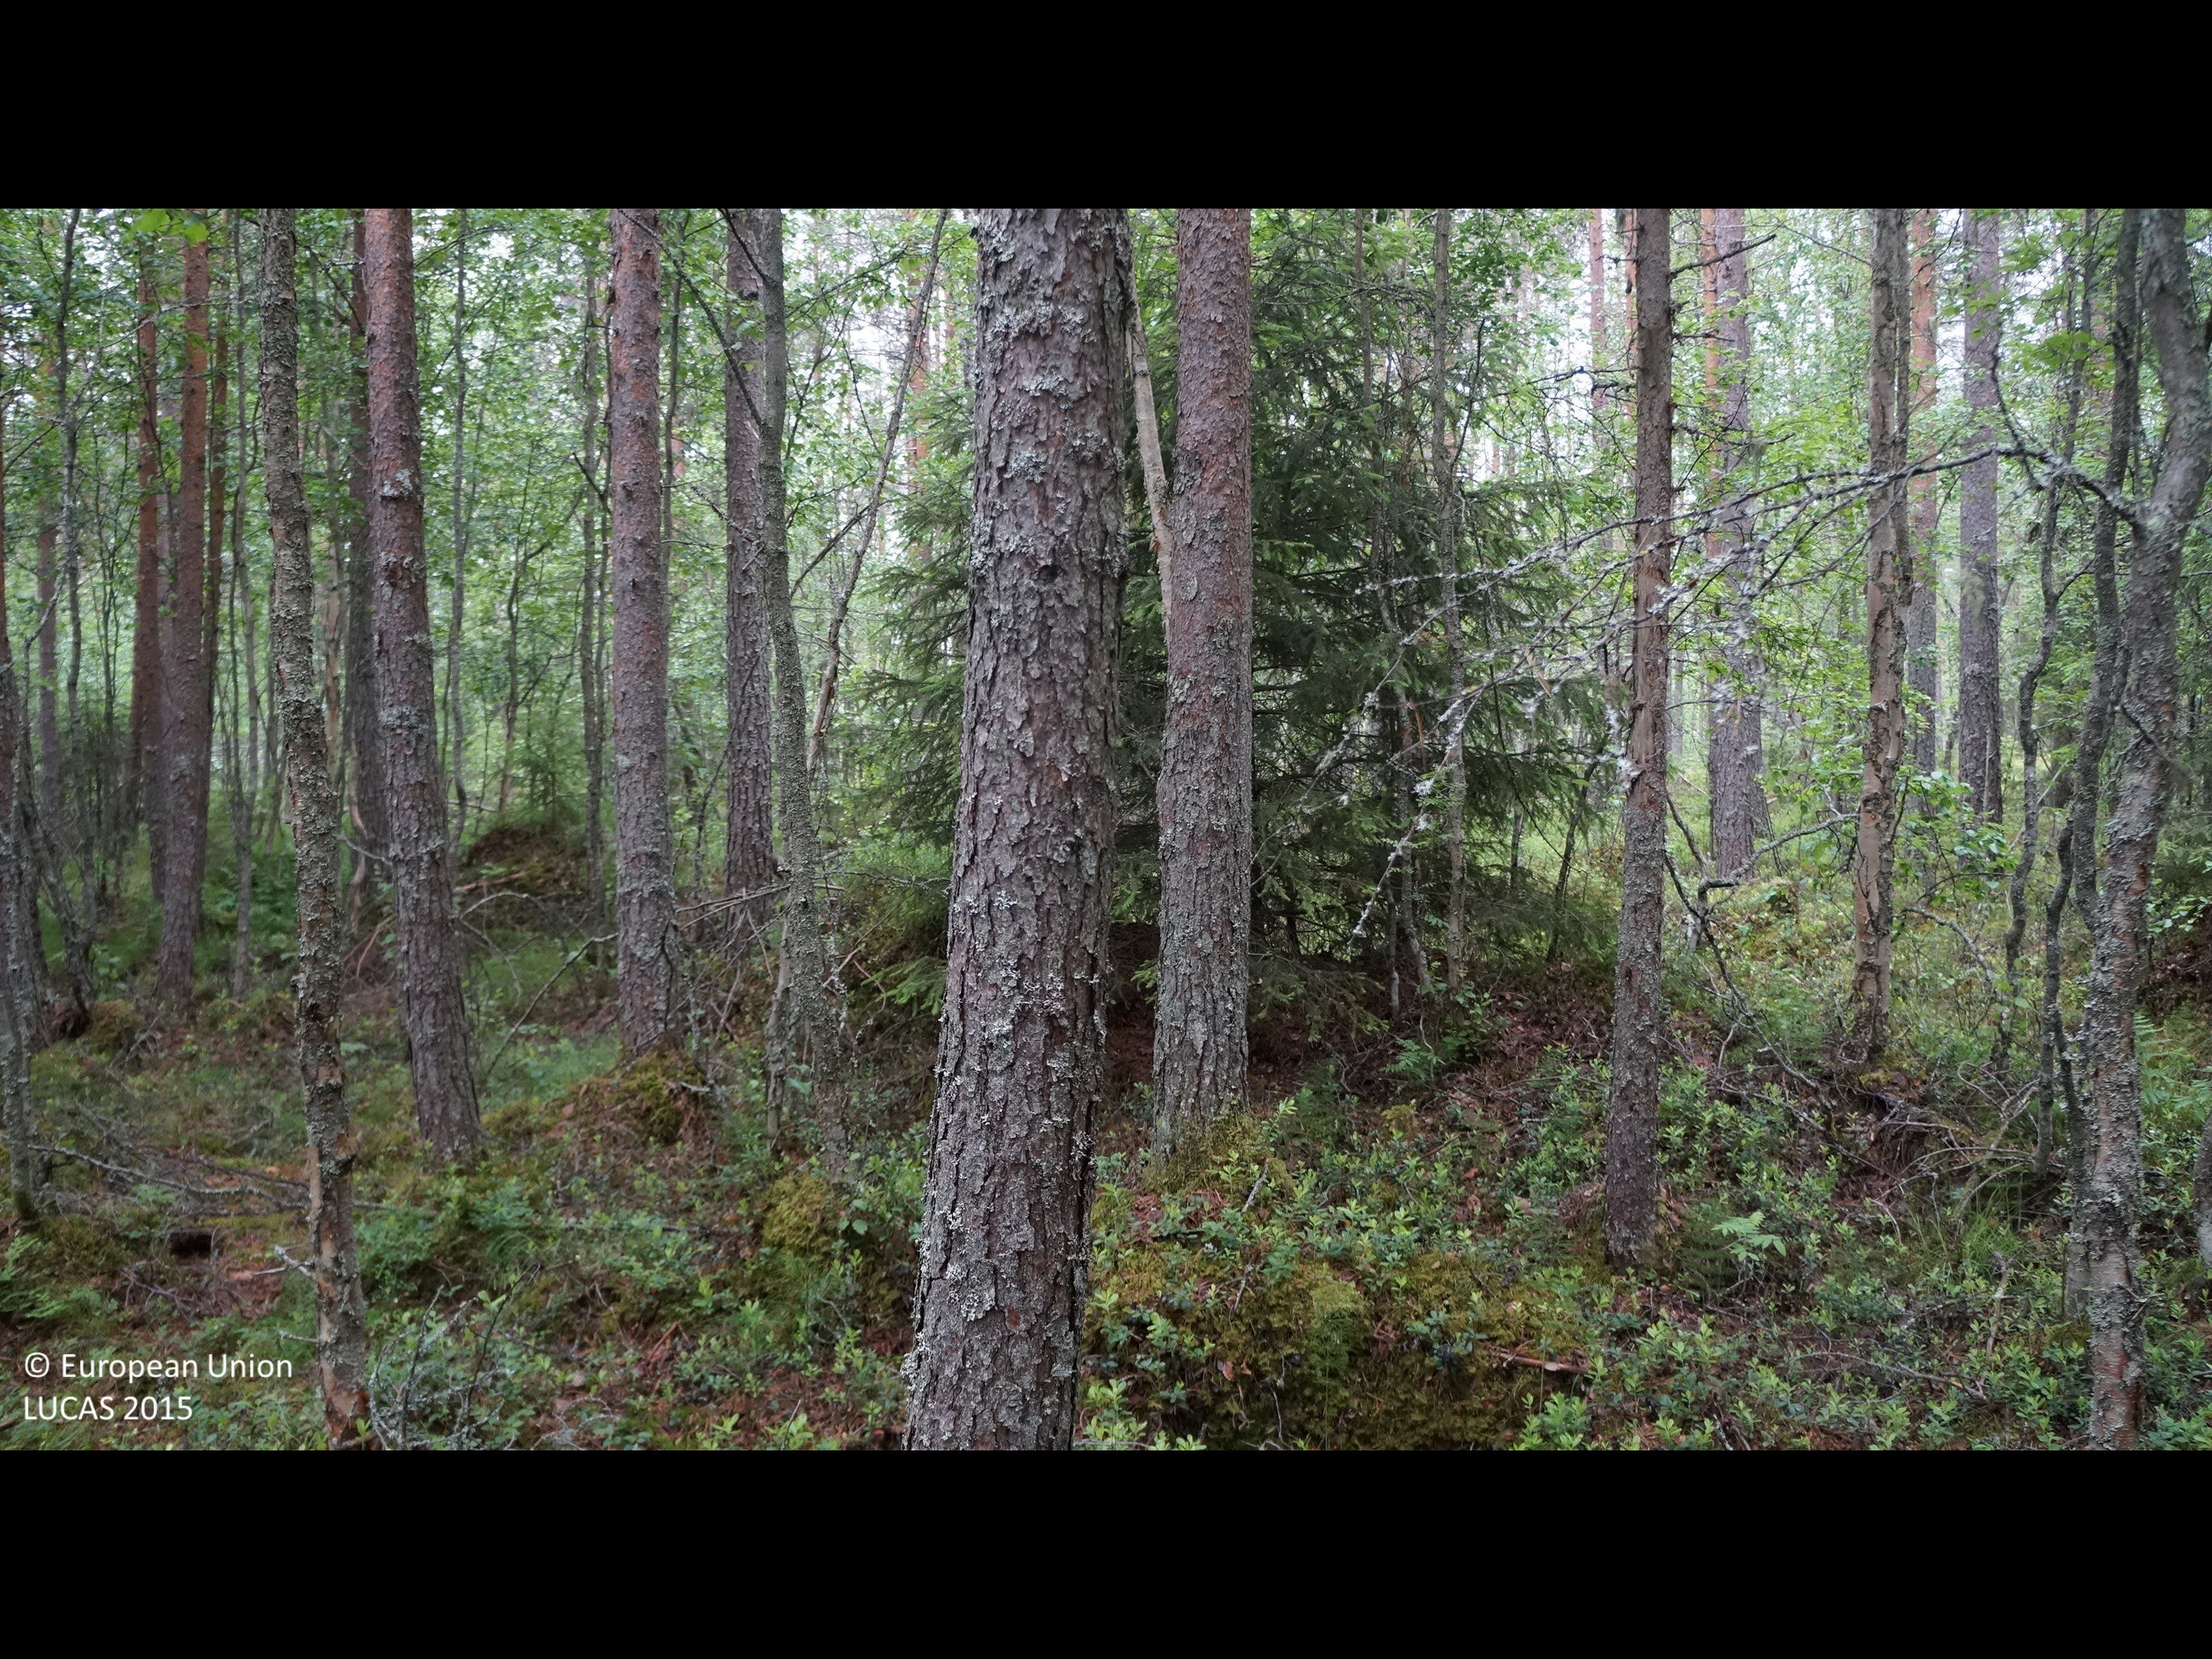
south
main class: Woodland
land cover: Pine dominated mixed woodland
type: boreal forest
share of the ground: > 75 %
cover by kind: coniferous forest trees 45 %, broadleaved forest trees 30 %, shrubs 15 %, lichens and mosses 10 %
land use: Forestry
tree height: > 5 m
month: June
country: FI
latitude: 64.3035
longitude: 24.6467
